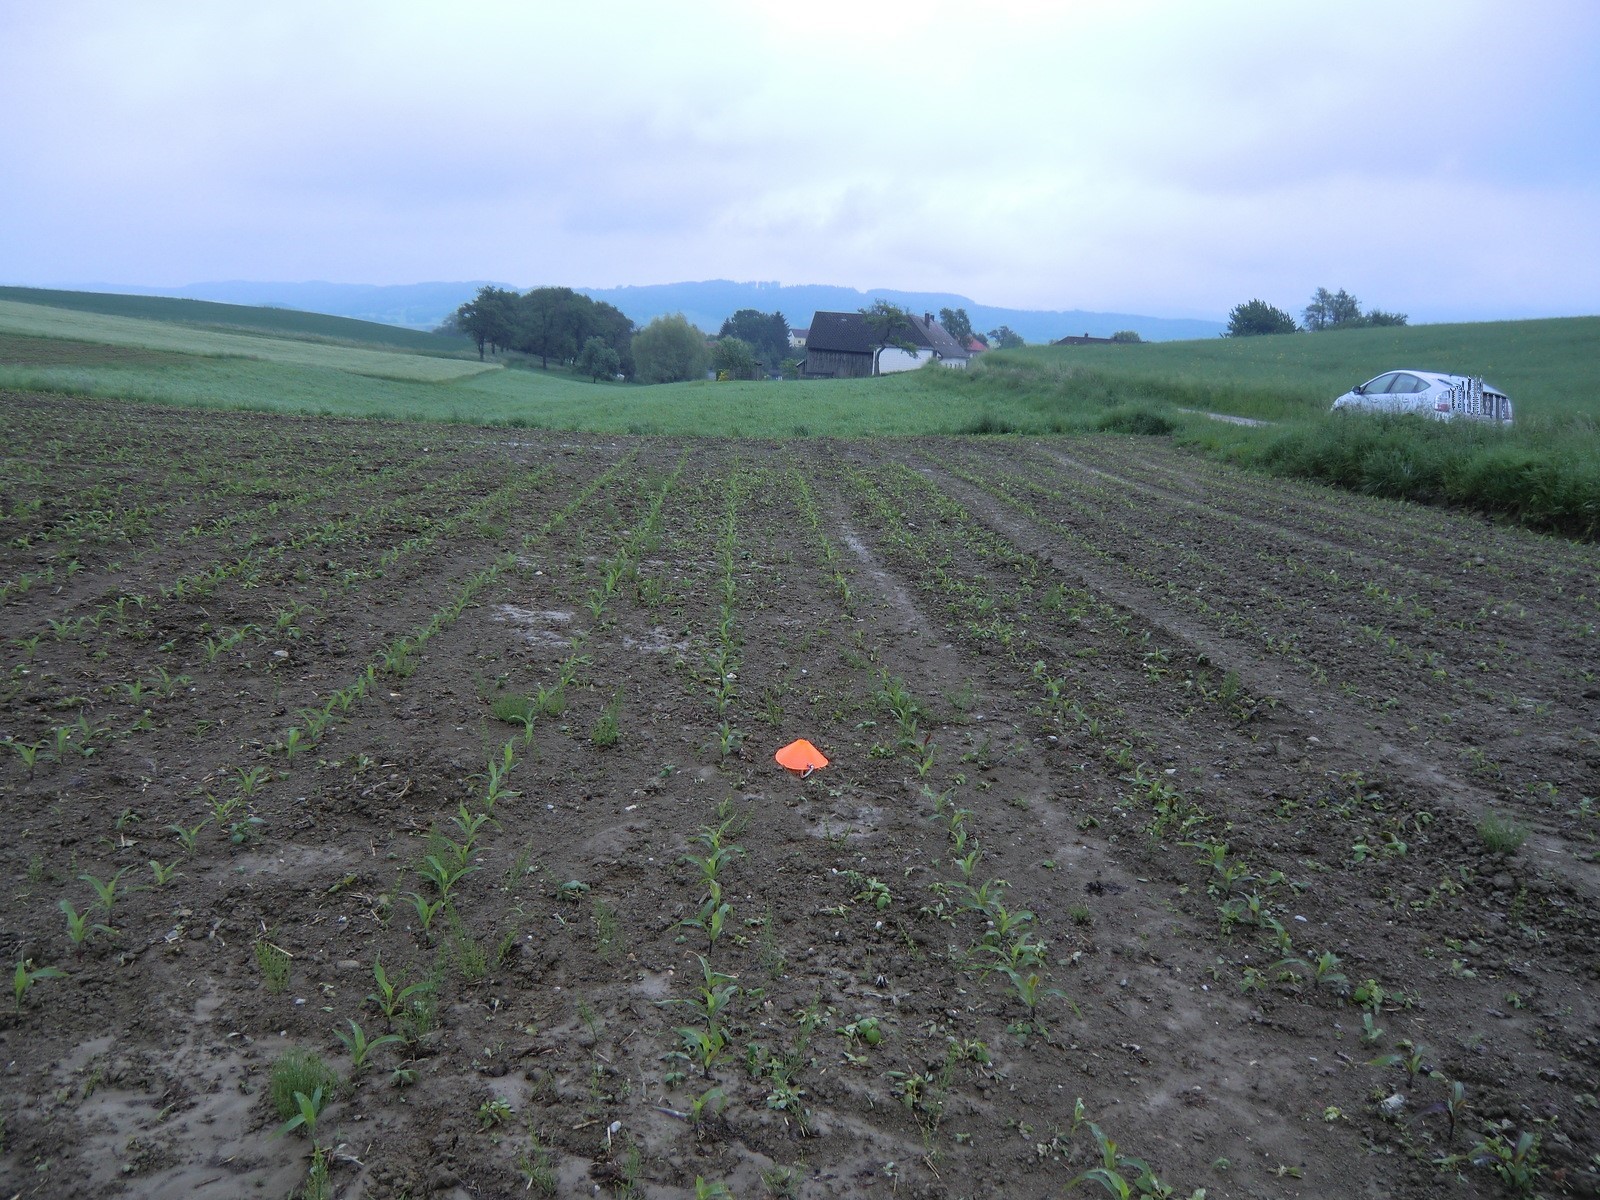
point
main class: Cropland
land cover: Maize
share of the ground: 10 - 25 %
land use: Agriculture (excluding fallow land and kitchen gardens)
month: May
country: AT
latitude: 48.1099
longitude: 15.3877
